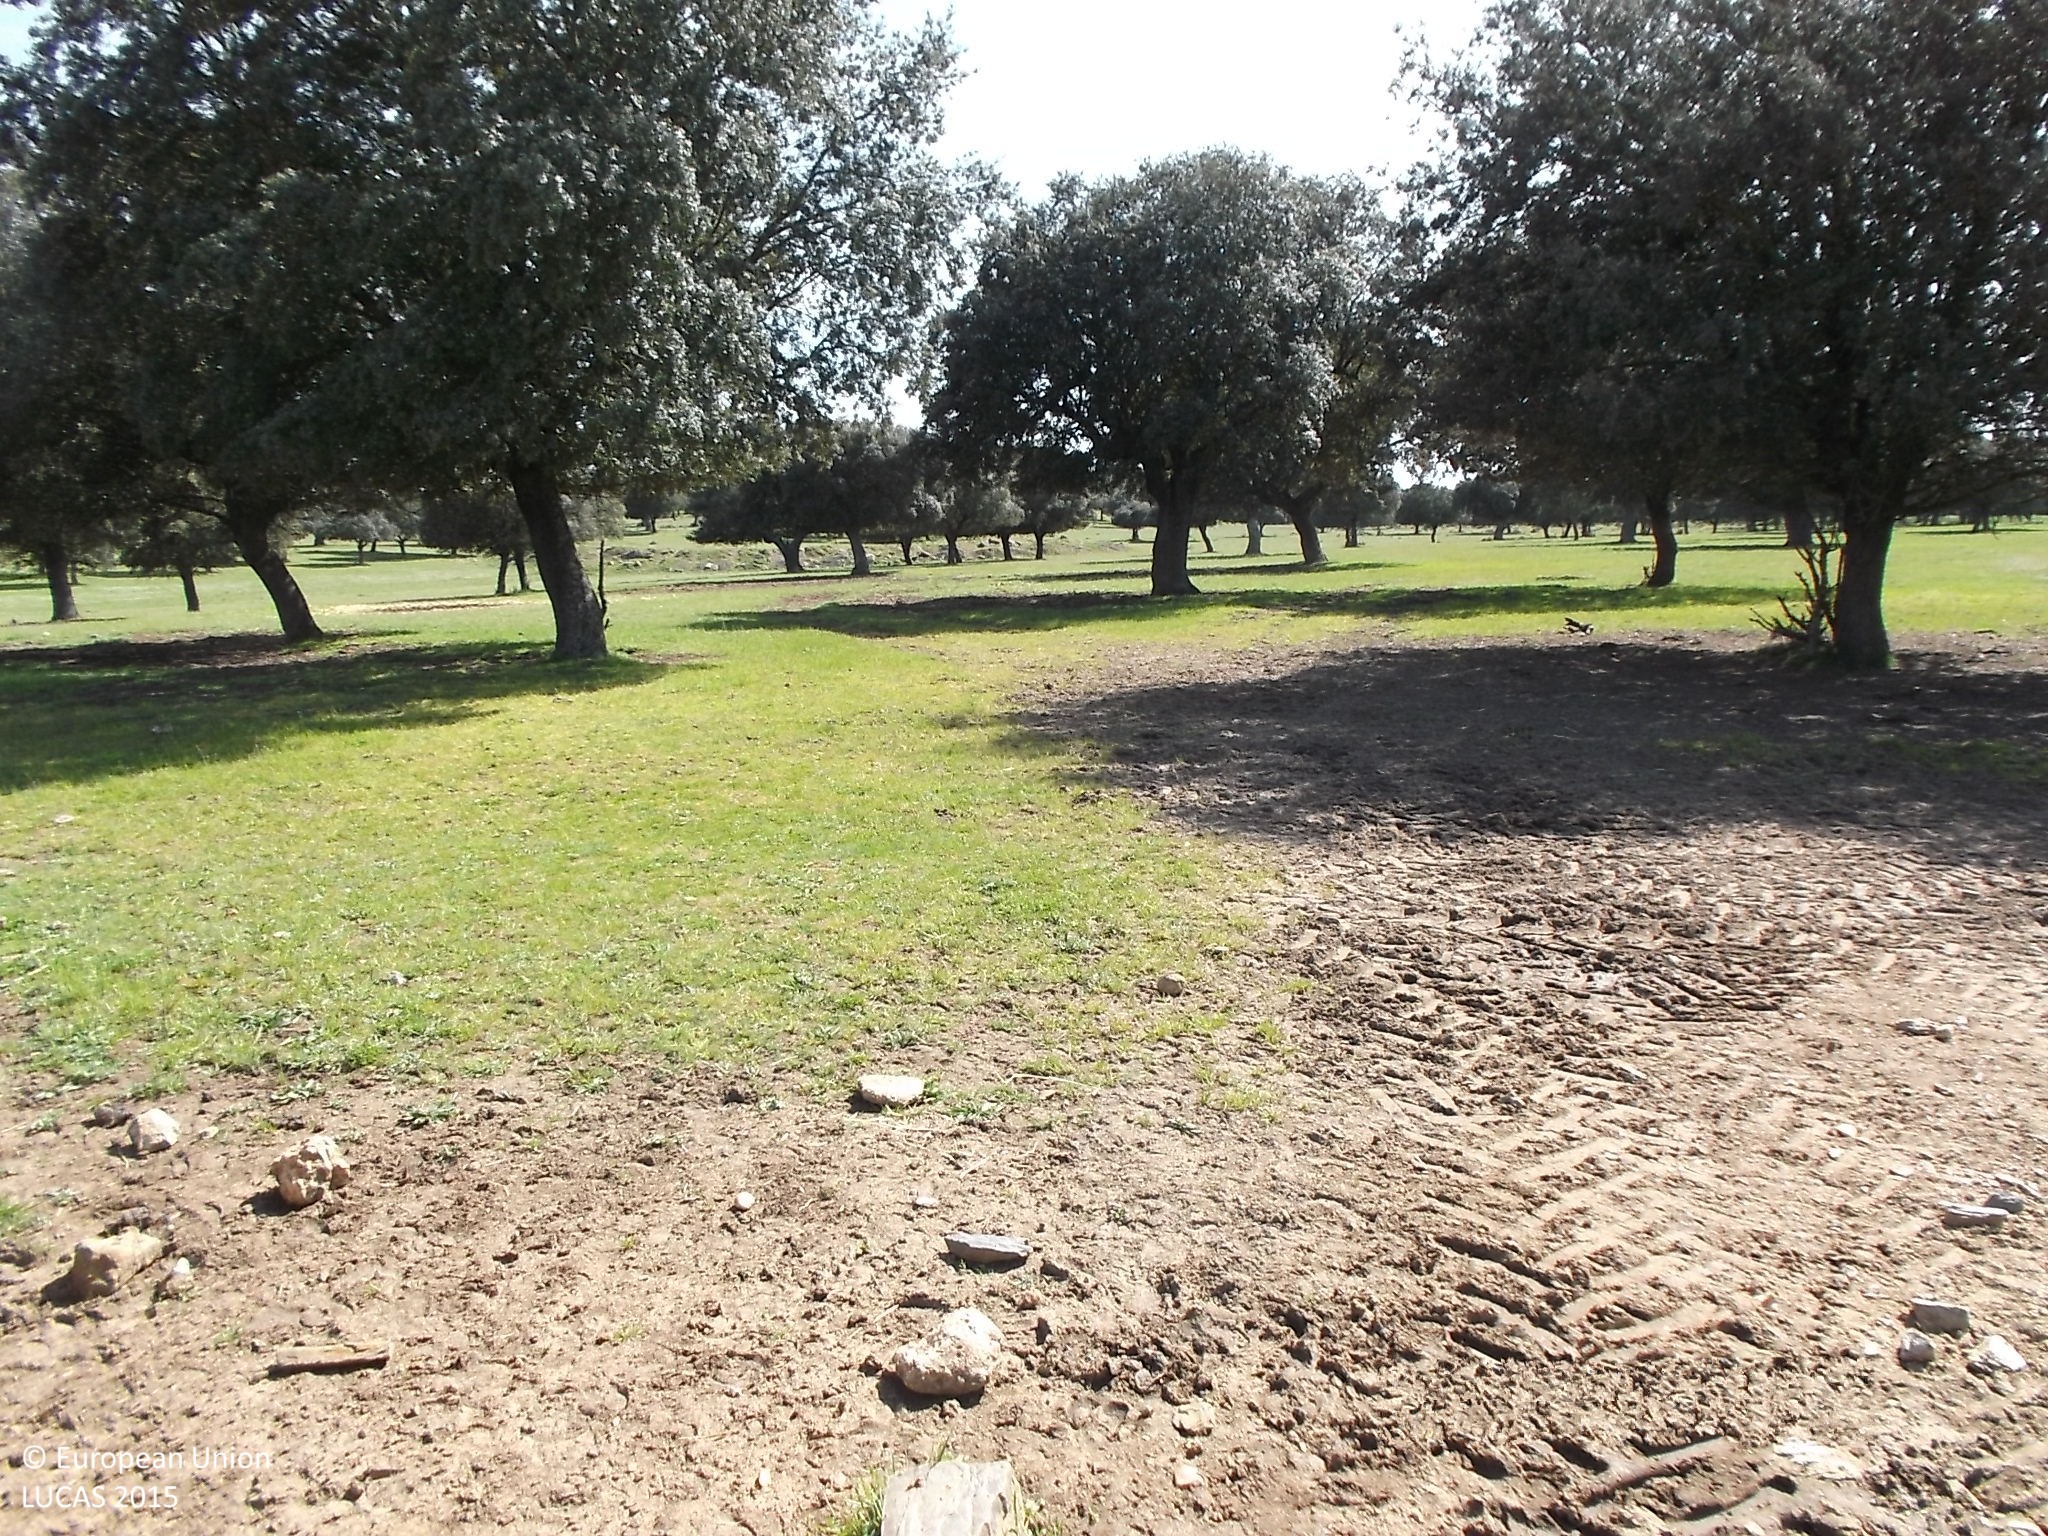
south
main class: Woodland
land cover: Broadleaved woodland
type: broadleaved evergreen forest
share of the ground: 25 - 50 %
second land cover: Grassland without tree/shrub cover
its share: 50 - 75 %
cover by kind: herbaceous plants 70 %, broadleaved forest trees 30 %
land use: Forestry
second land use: Agriculture (excluding fallow land and kitchen gardens)
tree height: > 5 m
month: April
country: ES
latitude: 40.9374
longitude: -5.9627
